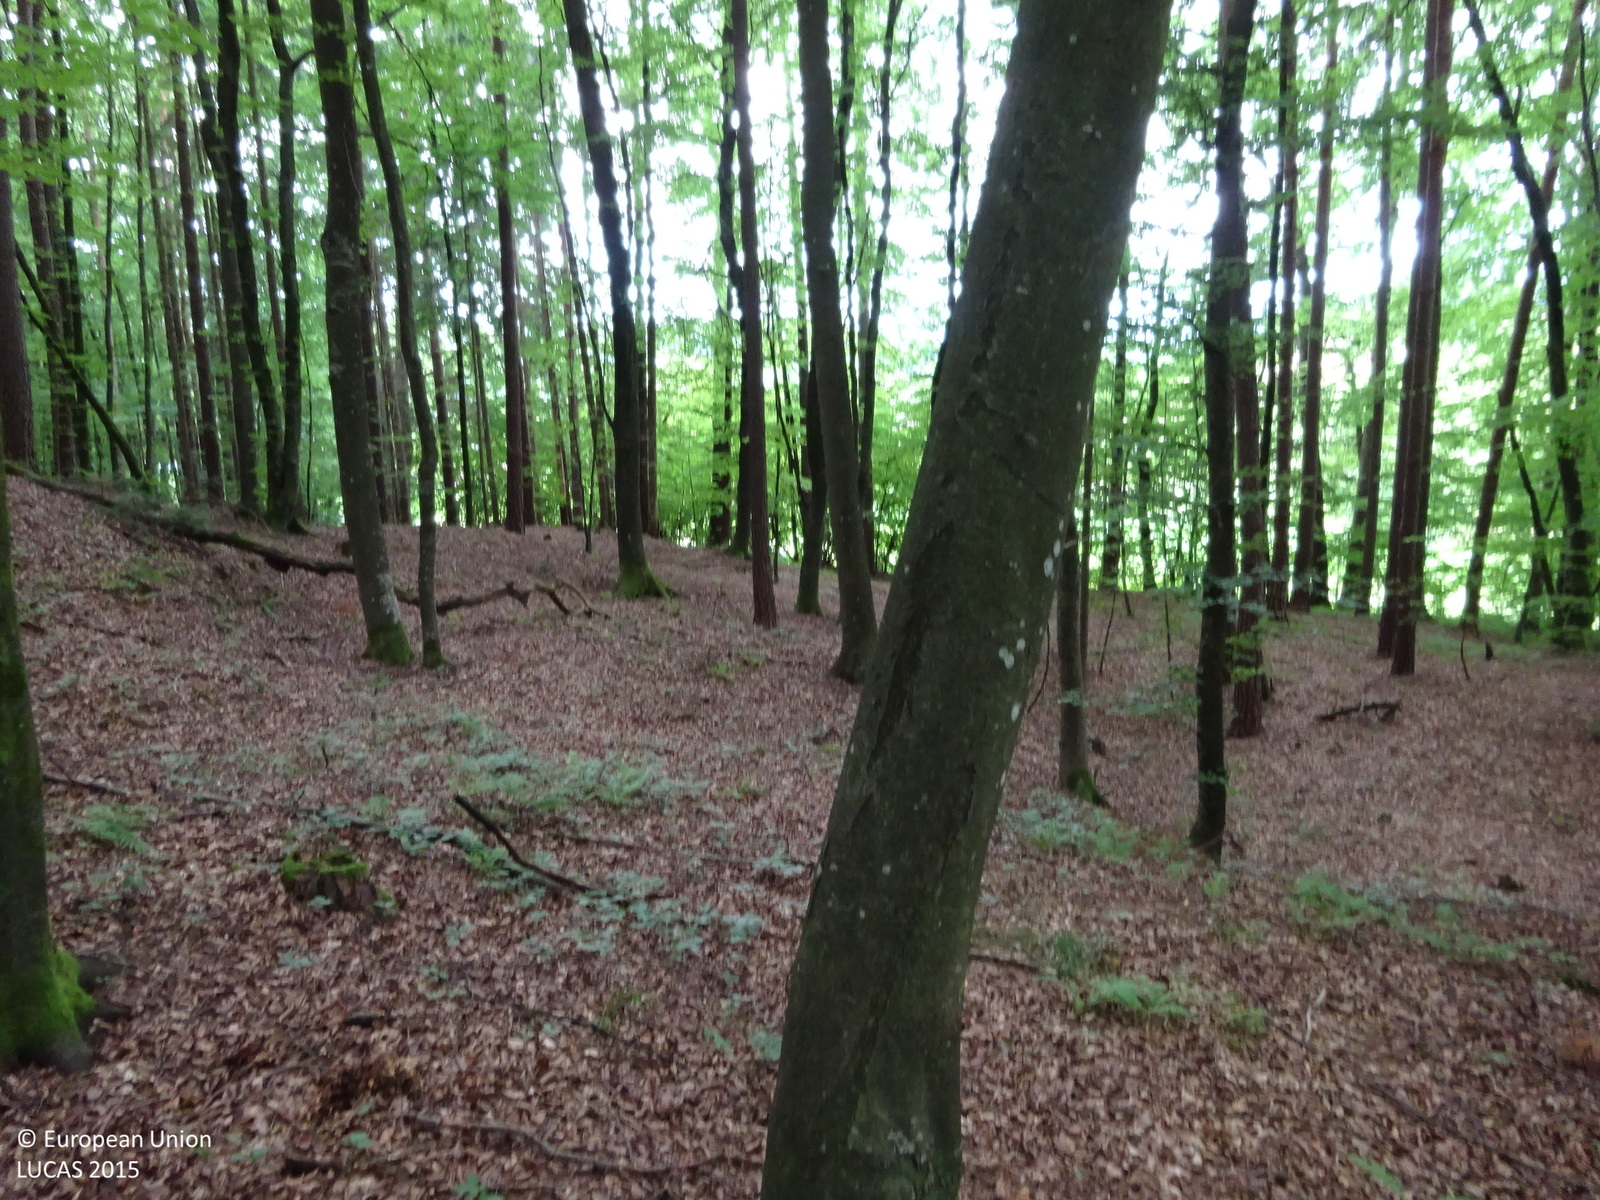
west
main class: Woodland
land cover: Broadleaved woodland
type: beech forest
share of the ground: > 75 %
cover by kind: broadleaved forest trees 80 %, coniferous forest trees 20 %
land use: Forestry
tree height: > 5 m
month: July
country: AT
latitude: 46.8098
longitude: 15.4115
